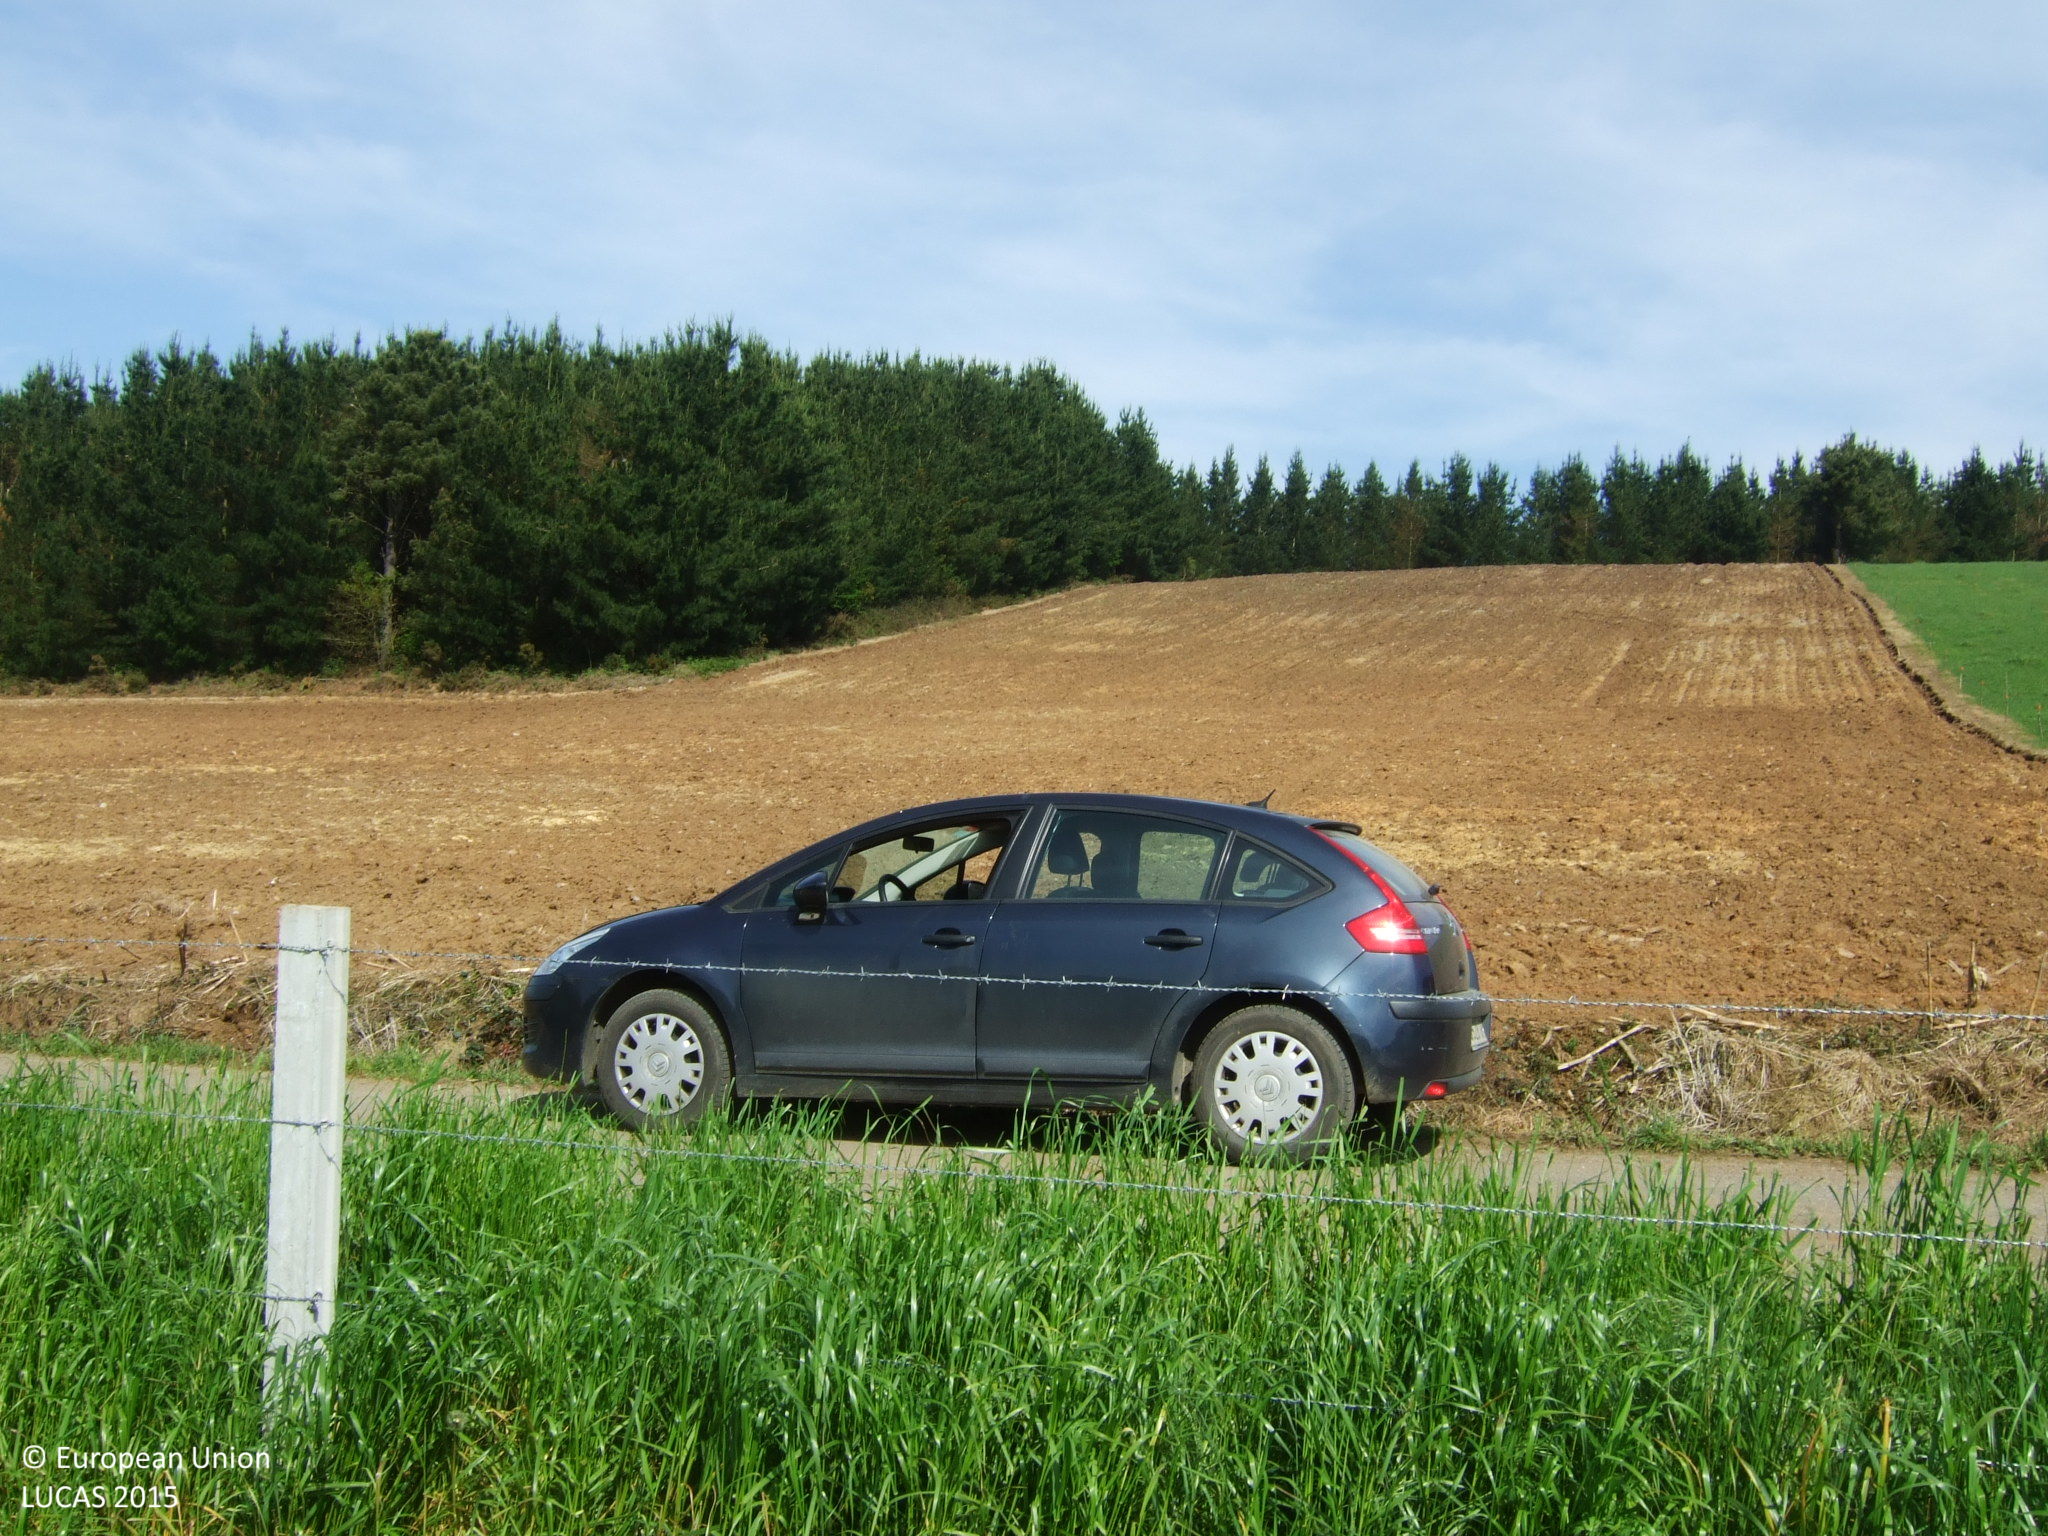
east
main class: Cropland
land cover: Temporary grasslands
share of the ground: > 75 %
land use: Agriculture (excluding fallow land and kitchen gardens)
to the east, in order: Temporary grasslands; Fences; Tracks; Other bare soil; Pine dominated coniferous woodland; Tracks; Pine dominated coniferous woodland
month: May
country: ES
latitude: 43.1298
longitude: -7.3693
